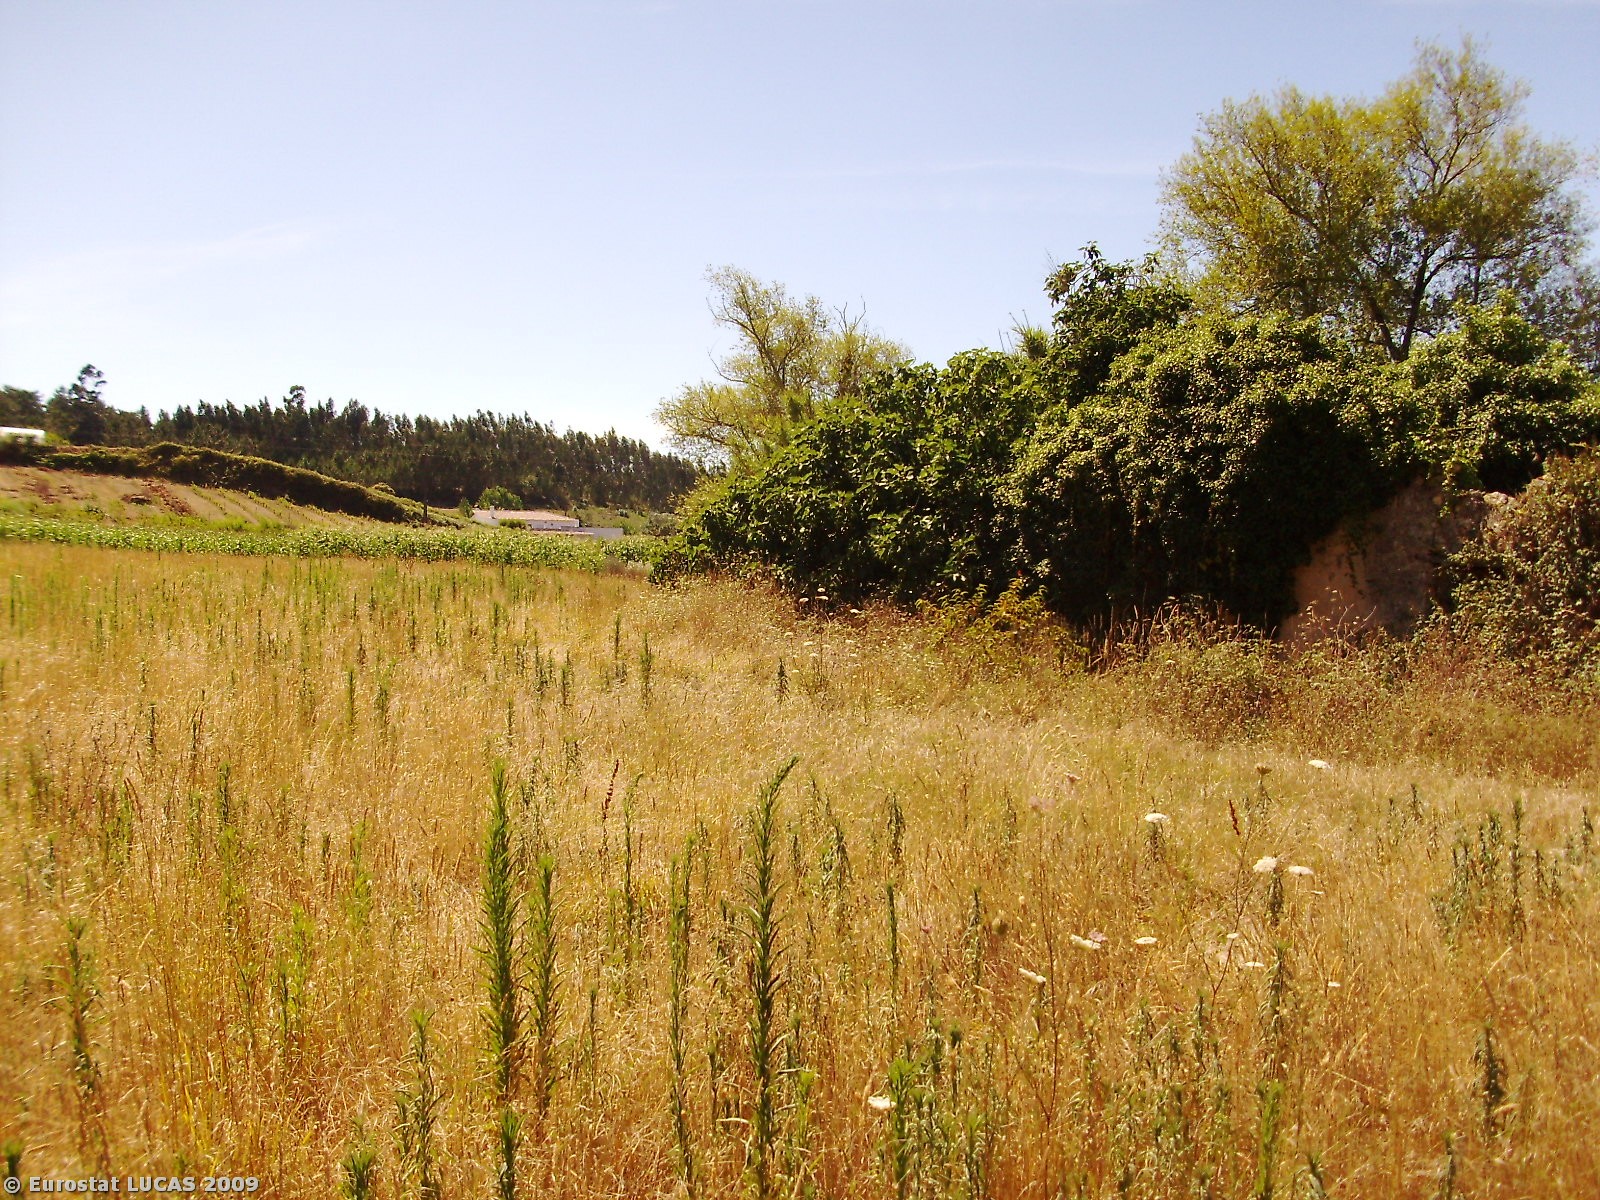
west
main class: Grassland
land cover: Spontaneously vegetated surfaces
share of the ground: > 75 %
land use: Fallow land
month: July
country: PT
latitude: 39.6769
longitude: -8.8683
